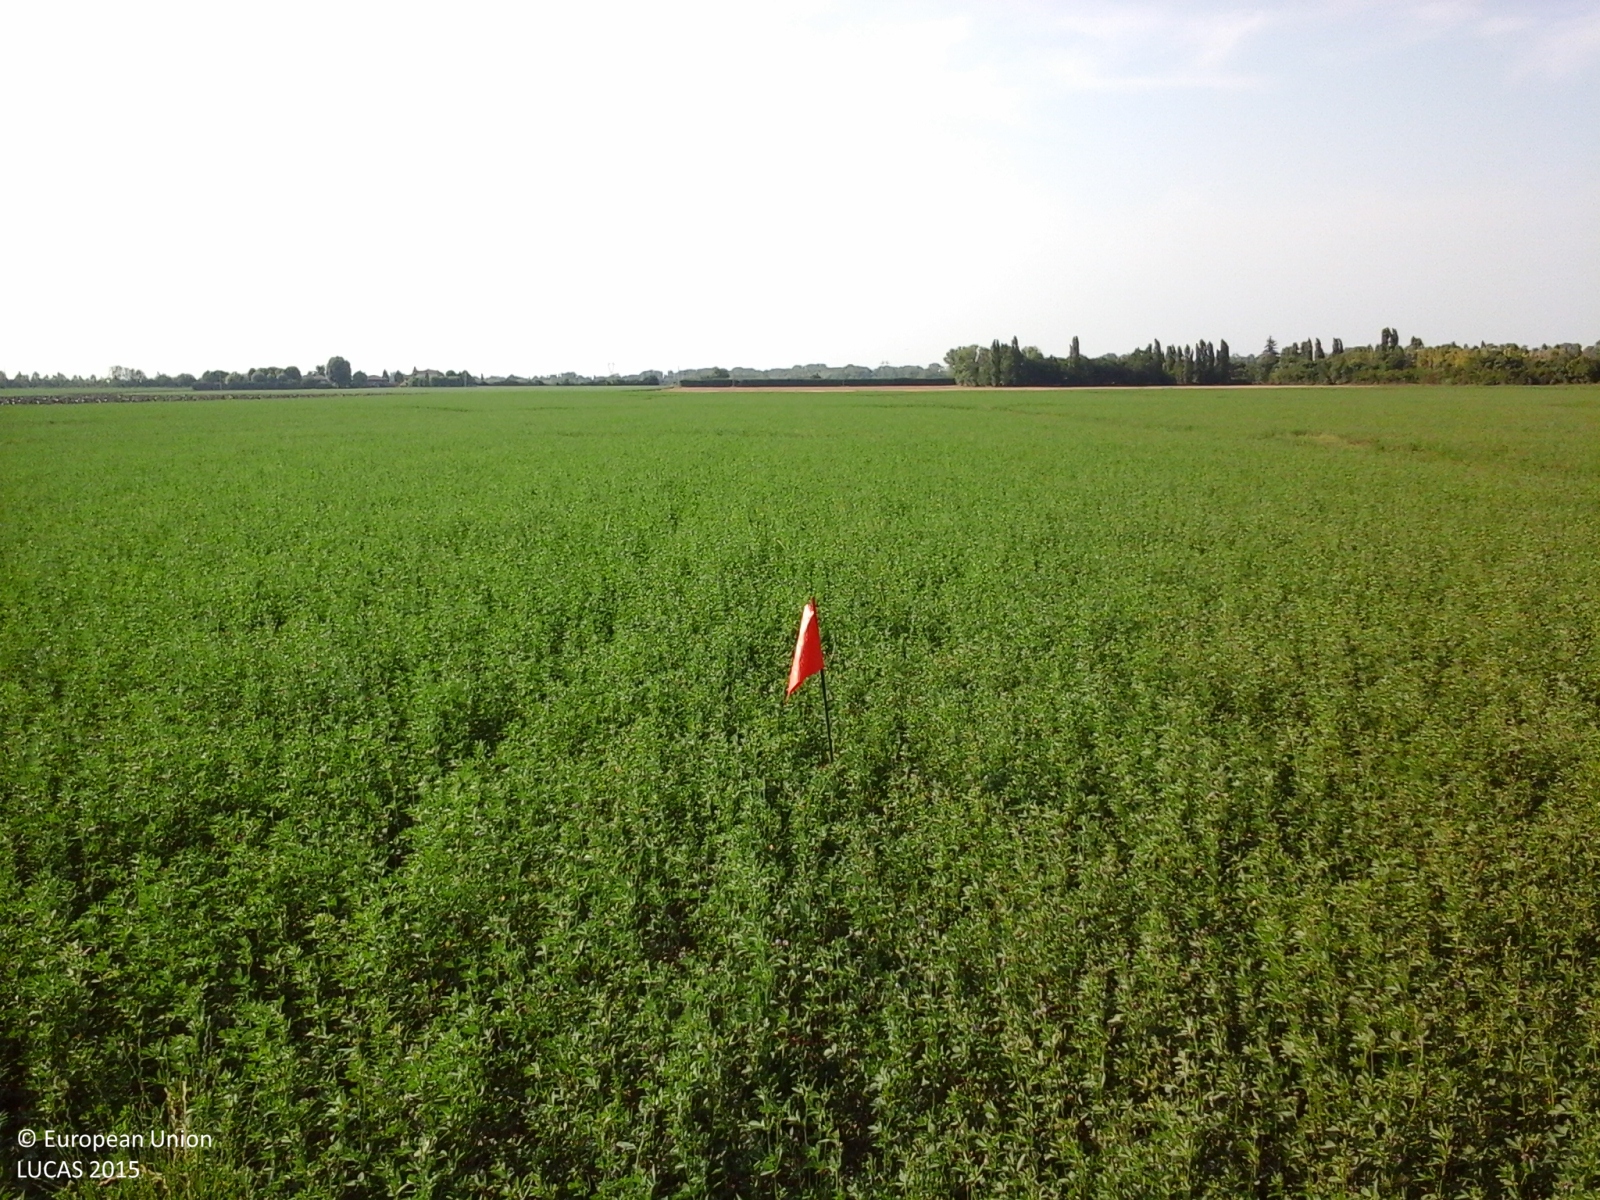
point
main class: Cropland
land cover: Lucerne
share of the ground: > 75 %
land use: Agriculture (excluding fallow land and kitchen gardens)
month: July
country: IT
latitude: 44.5540
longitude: 11.6456
